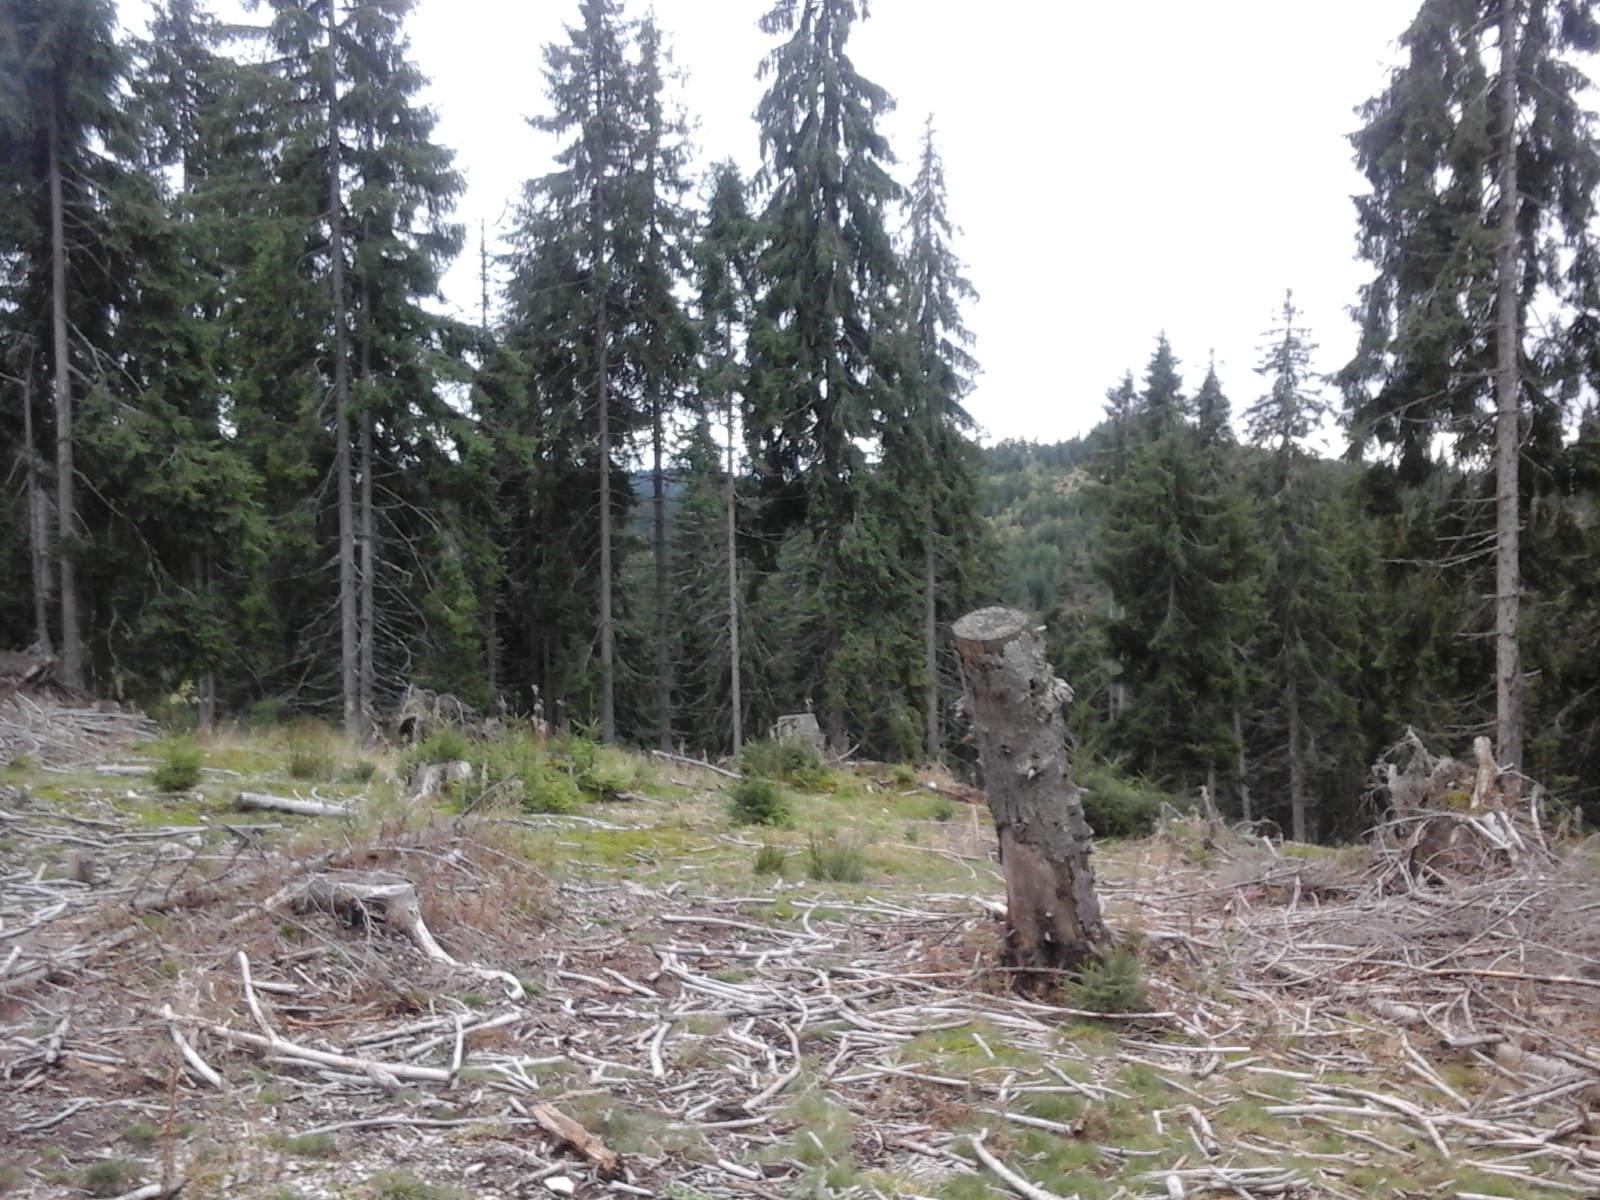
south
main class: Grassland
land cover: Grassland with sparse tree/shrub cover
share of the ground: > 75 %
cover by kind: herbaceous plants 95 %, coniferous forest trees 5 %
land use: Forestry
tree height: > 5 m
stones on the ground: 10 - 25 %
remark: Clear cut
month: September
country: RO
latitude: 46.5386
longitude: 22.8488
